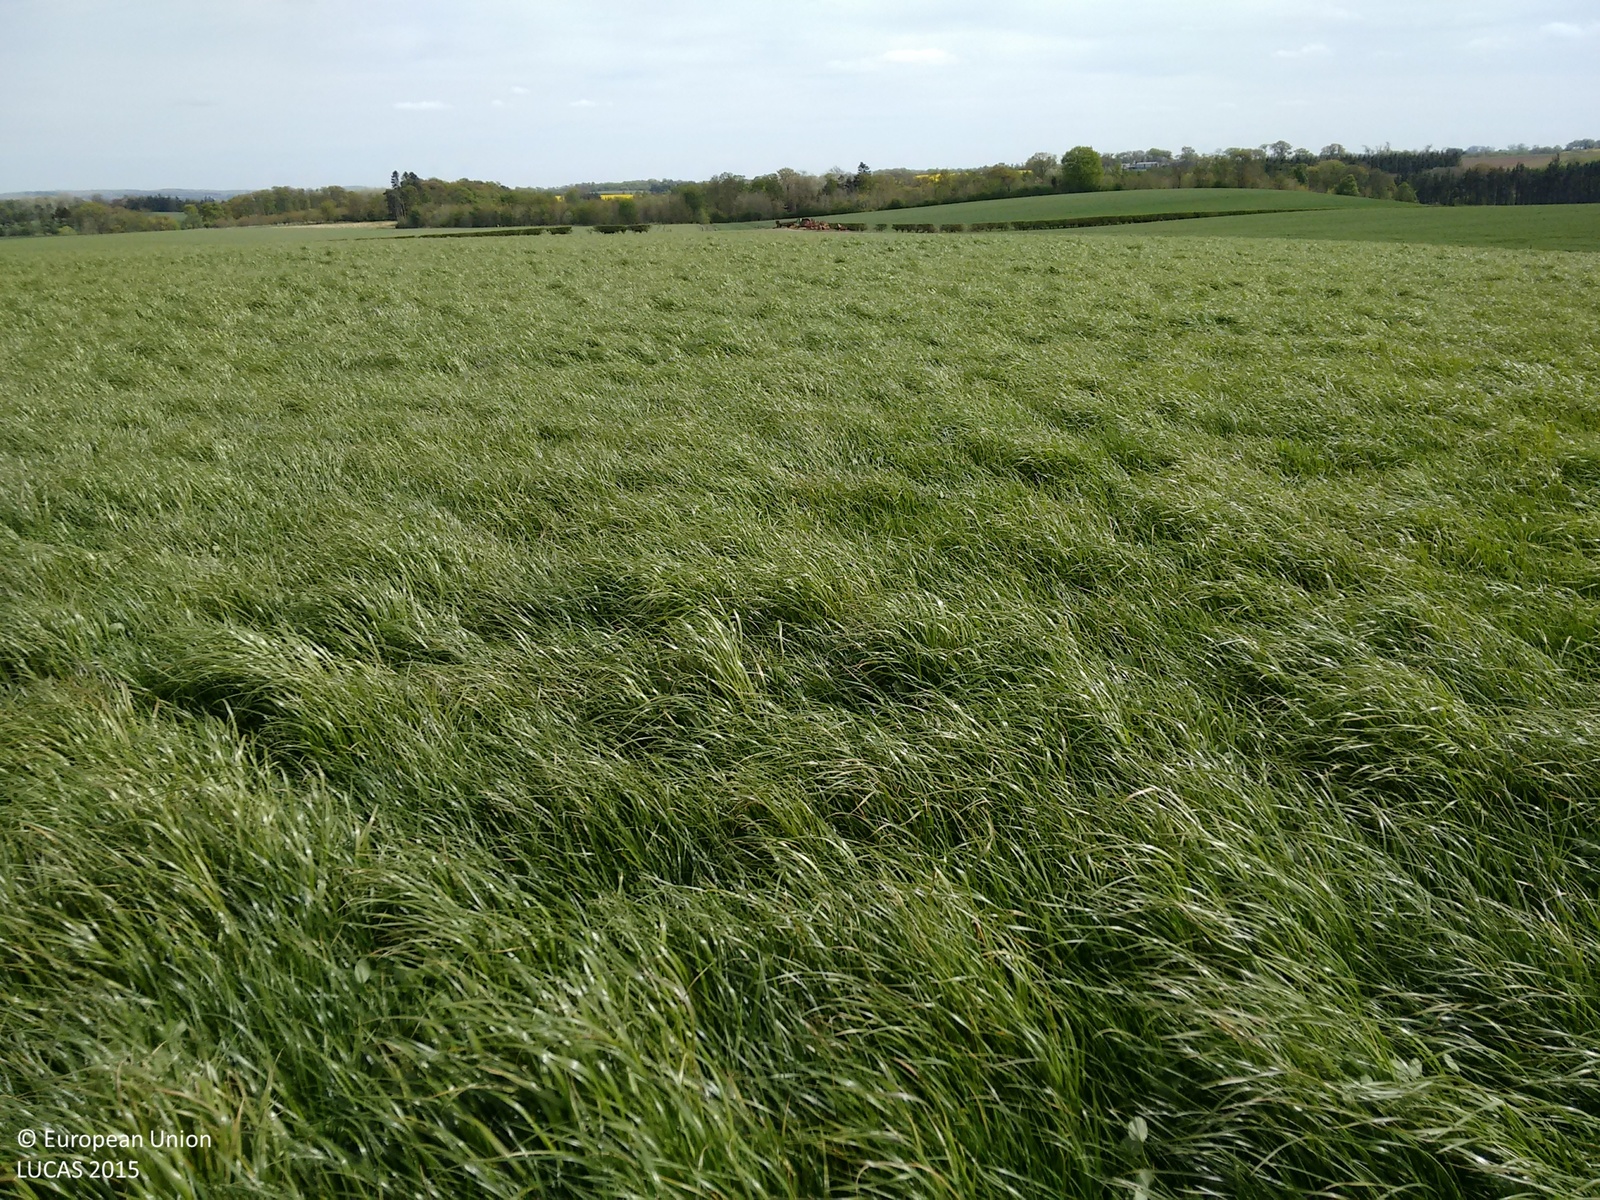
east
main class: Cropland
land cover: Barley
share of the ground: > 75 %
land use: Agriculture (excluding fallow land and kitchen gardens)
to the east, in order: Barley; Fences; Managed hedges; Grass margins; Barley
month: May
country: GB
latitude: 55.7799
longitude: -2.2533
